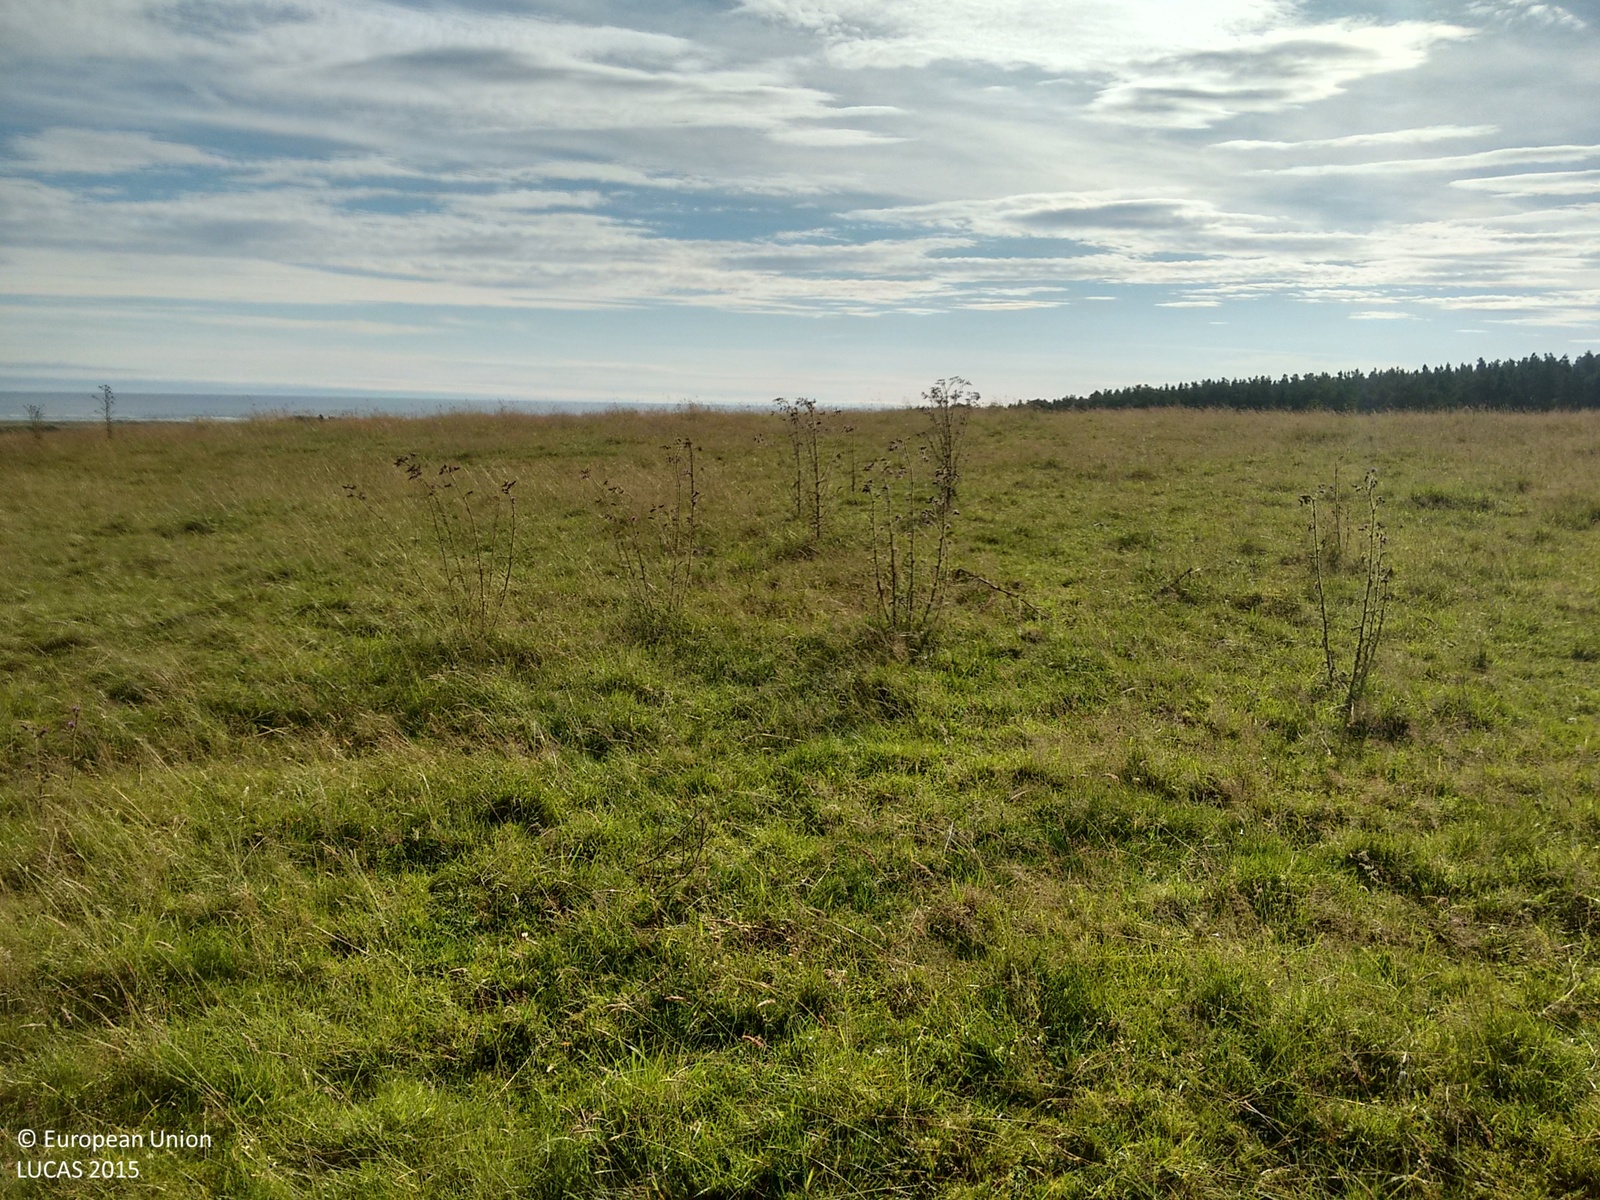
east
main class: Woodland
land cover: Pine dominated coniferous woodland
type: exotic forest
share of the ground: > 75 %
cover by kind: coniferous forest trees 60 %, herbaceous plants 40 %
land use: Forestry
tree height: > 5 m
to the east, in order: Pine dominated coniferous woodland; Fences; Grassland without tree/shrub cover; Fences; Grassland without tree/shrub cover; Fences; Shrubland without tree cover; Grassland without tree/shrub cover; Ditches and canals; Grassland without tree/shrub cover
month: August
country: GB
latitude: 57.9168
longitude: -4.0386
